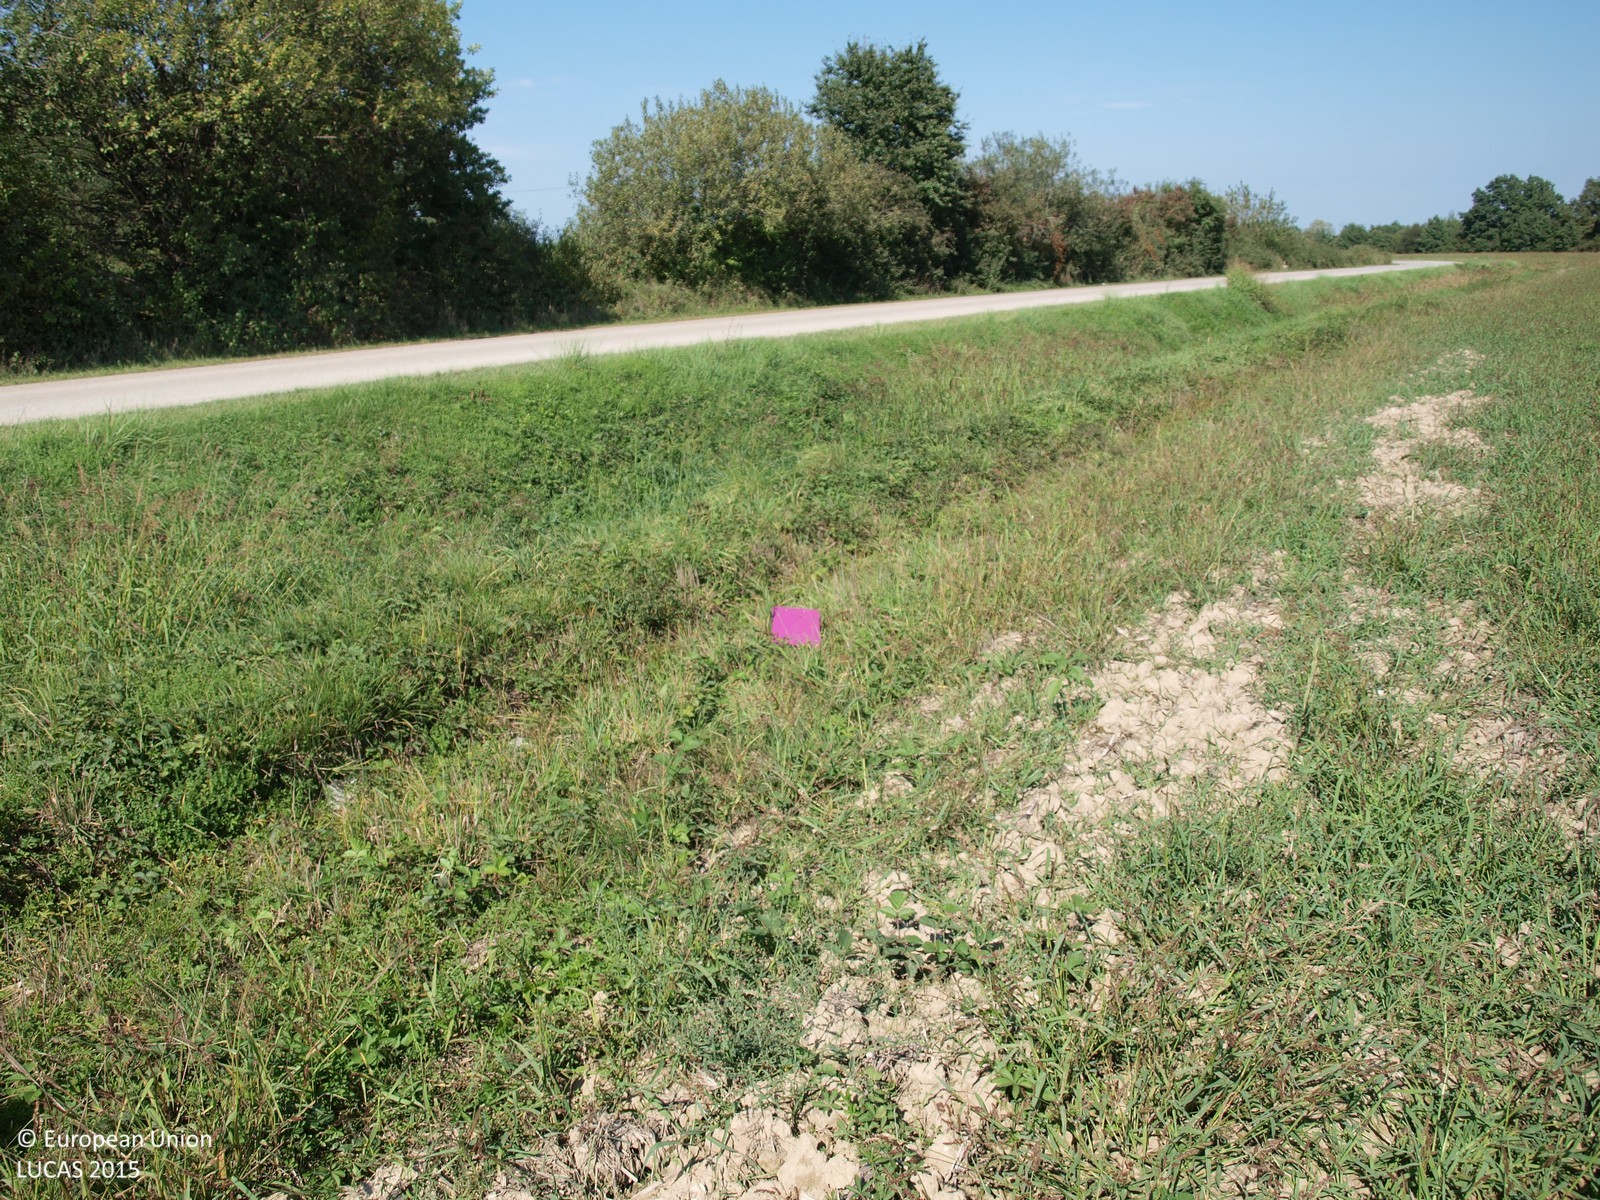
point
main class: Grassland
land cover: Grassland without tree/shrub cover
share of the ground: > 75 %
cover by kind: herbaceous plants 100 %
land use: Agriculture (excluding fallow land and kitchen gardens)
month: September
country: HR
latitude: 45.6536
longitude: 16.0932
